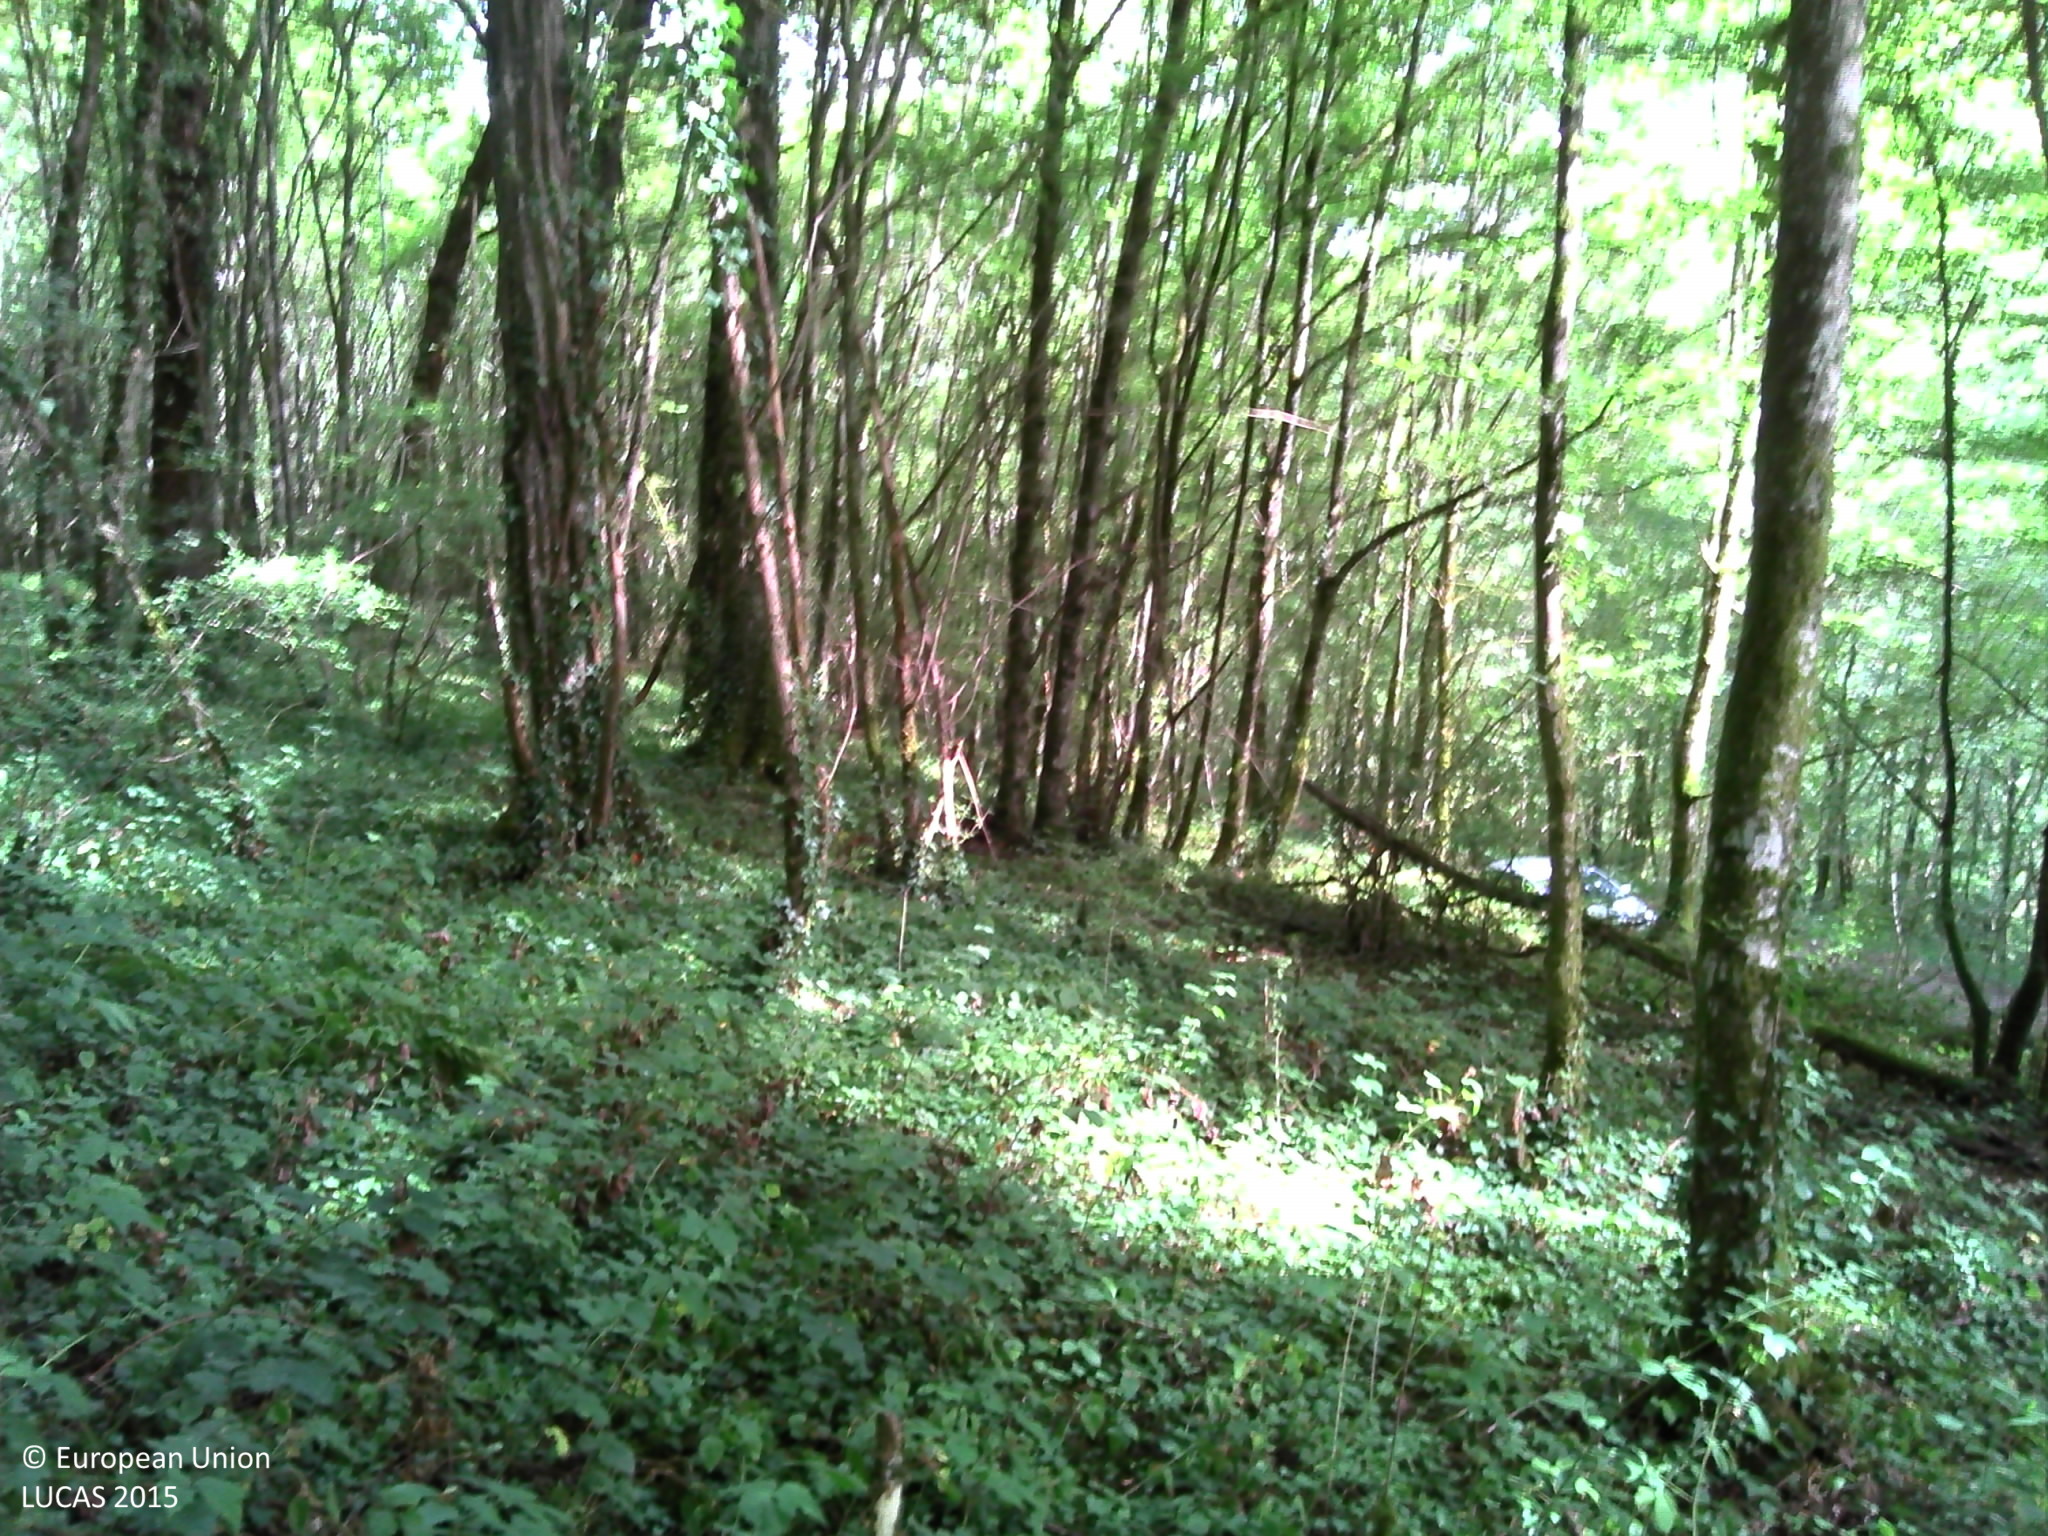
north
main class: Woodland
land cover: Broadleaved woodland
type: mesophytic deciduous forest
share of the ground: > 75 %
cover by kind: broadleaved forest trees 90 %, herbaceous plants 5 %, lichens and mosses 5 %
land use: Forestry
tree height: > 5 m
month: July
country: FR
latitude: 47.9154
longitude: 3.0756
